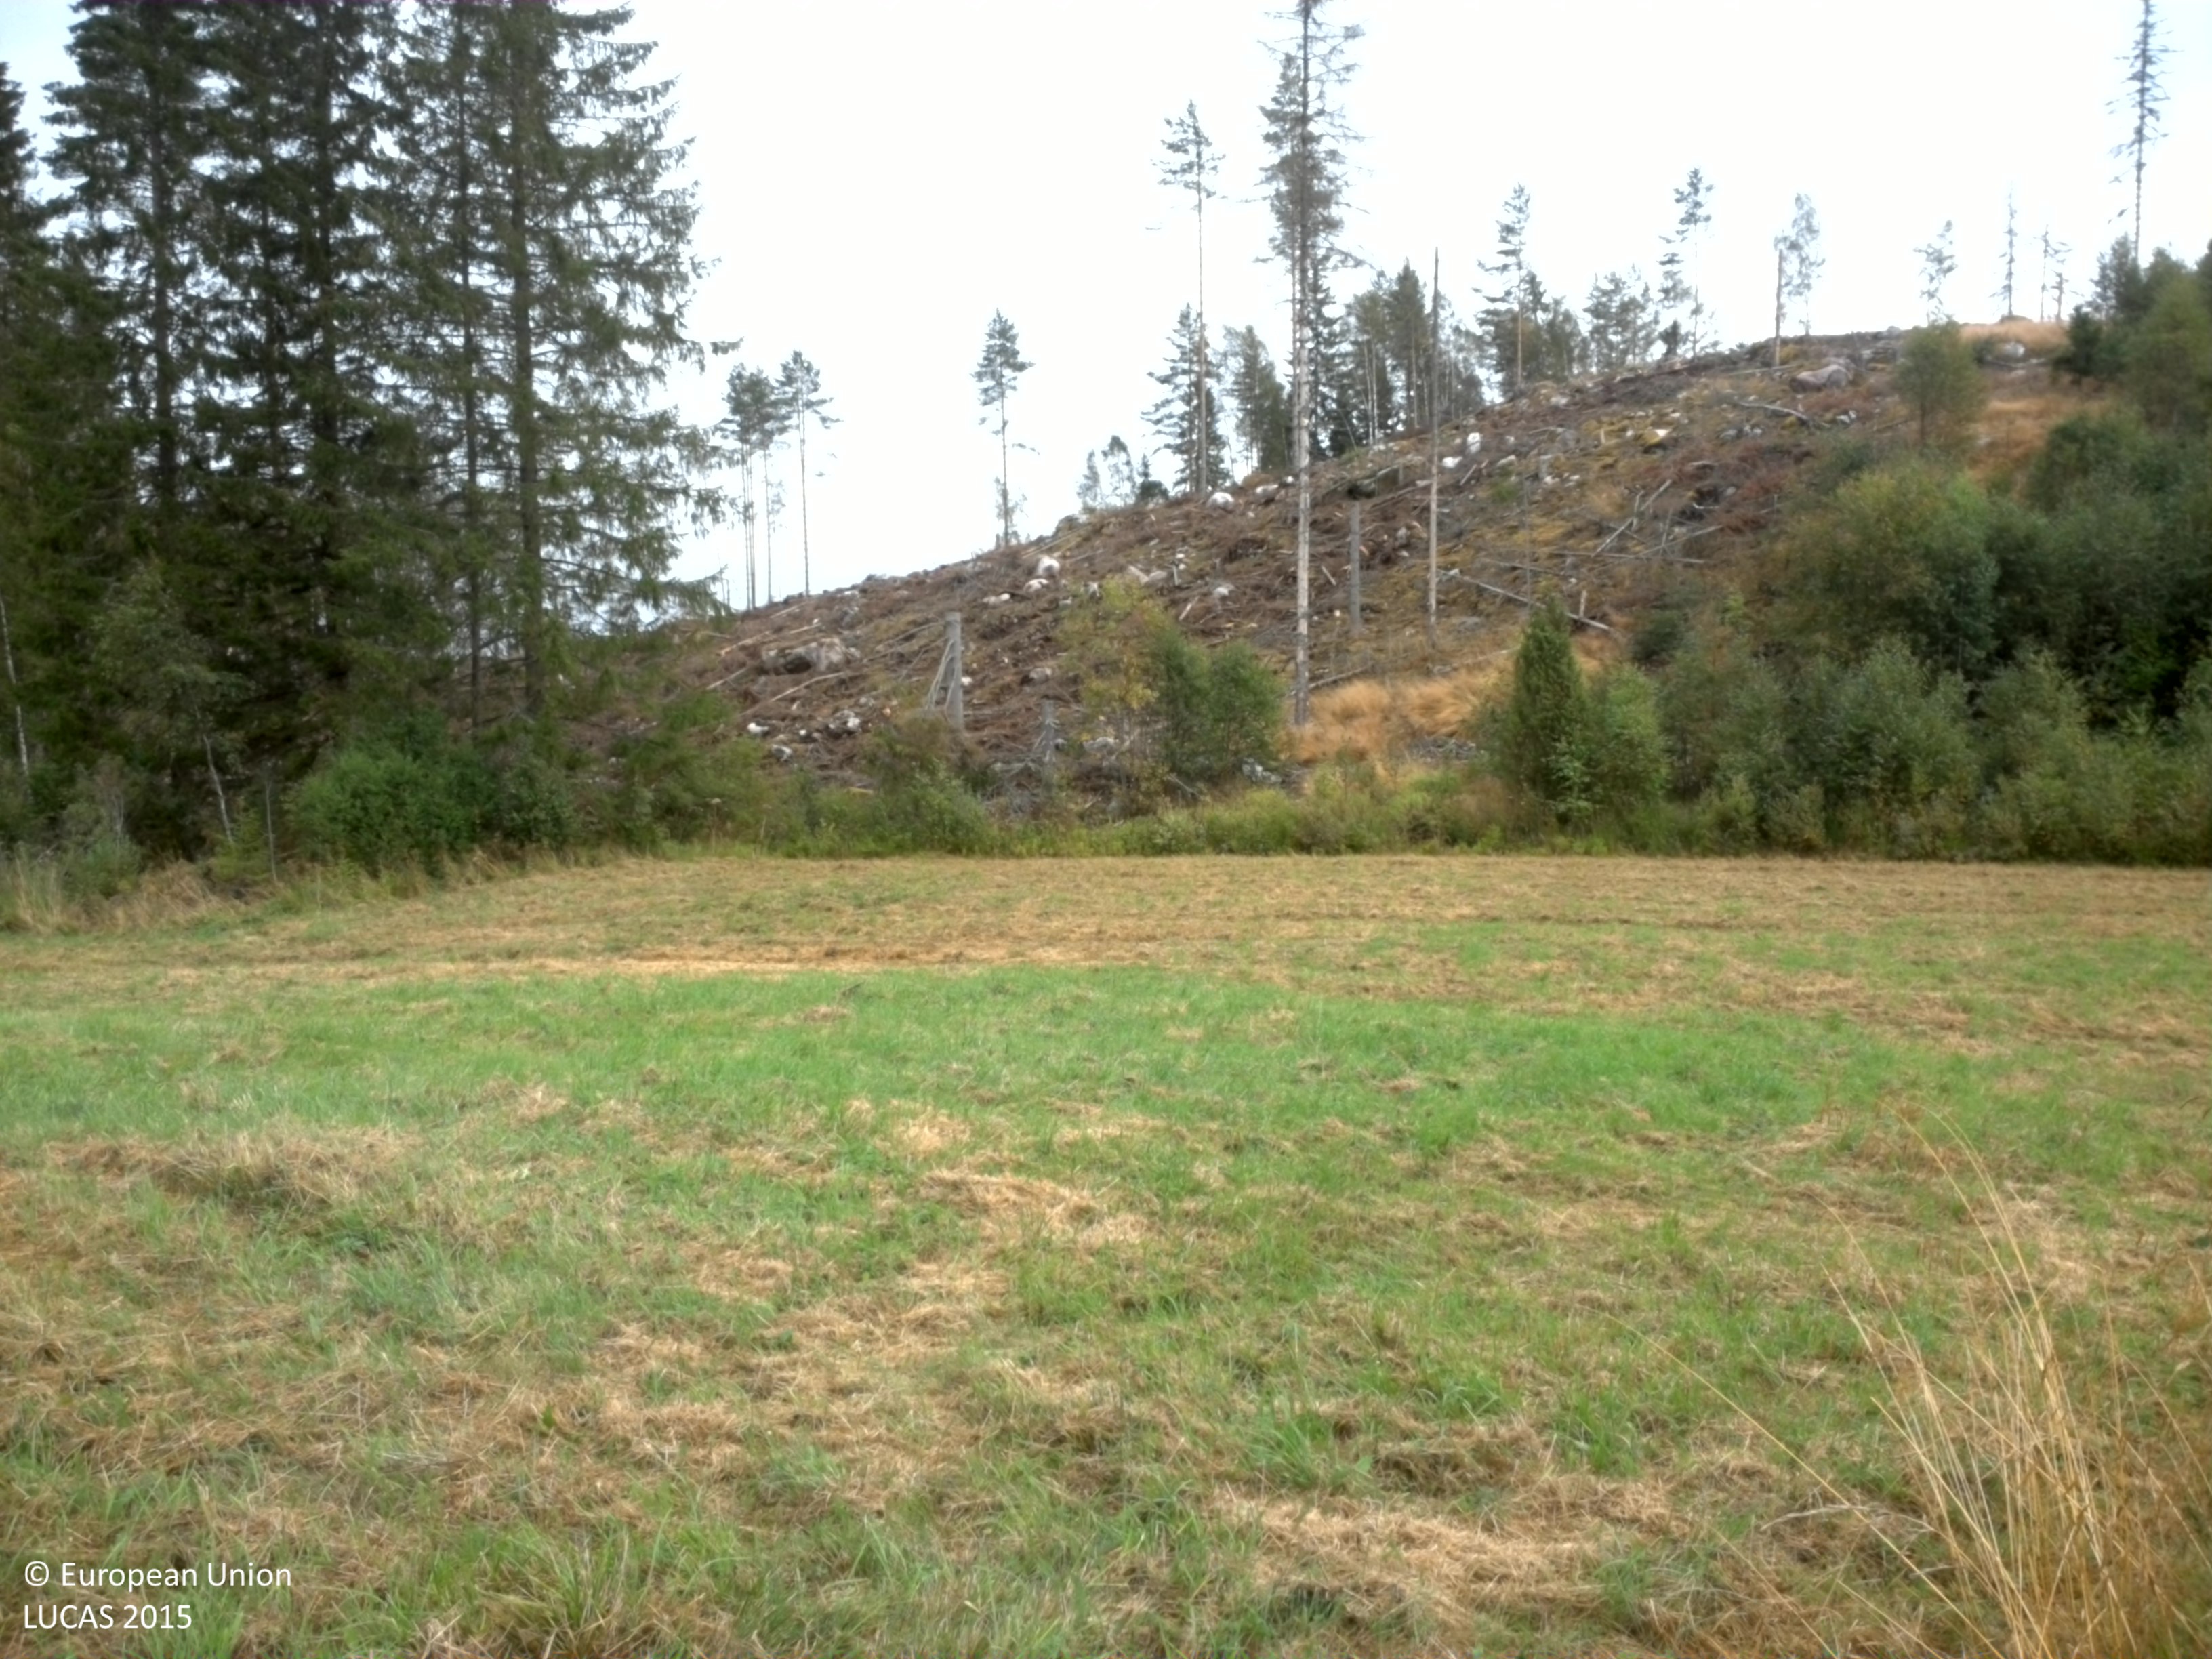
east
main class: Grassland
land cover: Grassland without tree/shrub cover
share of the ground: > 75 %
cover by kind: herbaceous plants 100 %
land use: Agriculture (excluding fallow land and kitchen gardens)
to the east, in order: Grassland without tree/shrub cover; Electric lines; Grassland without tree/shrub cover; Ditches and canals; Grassland with sparse tree/shrub cover; Spruce dominated mixed woodland; Grassland with sparse tree/shrub cover
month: August
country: SE
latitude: 59.7807
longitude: 15.6012
